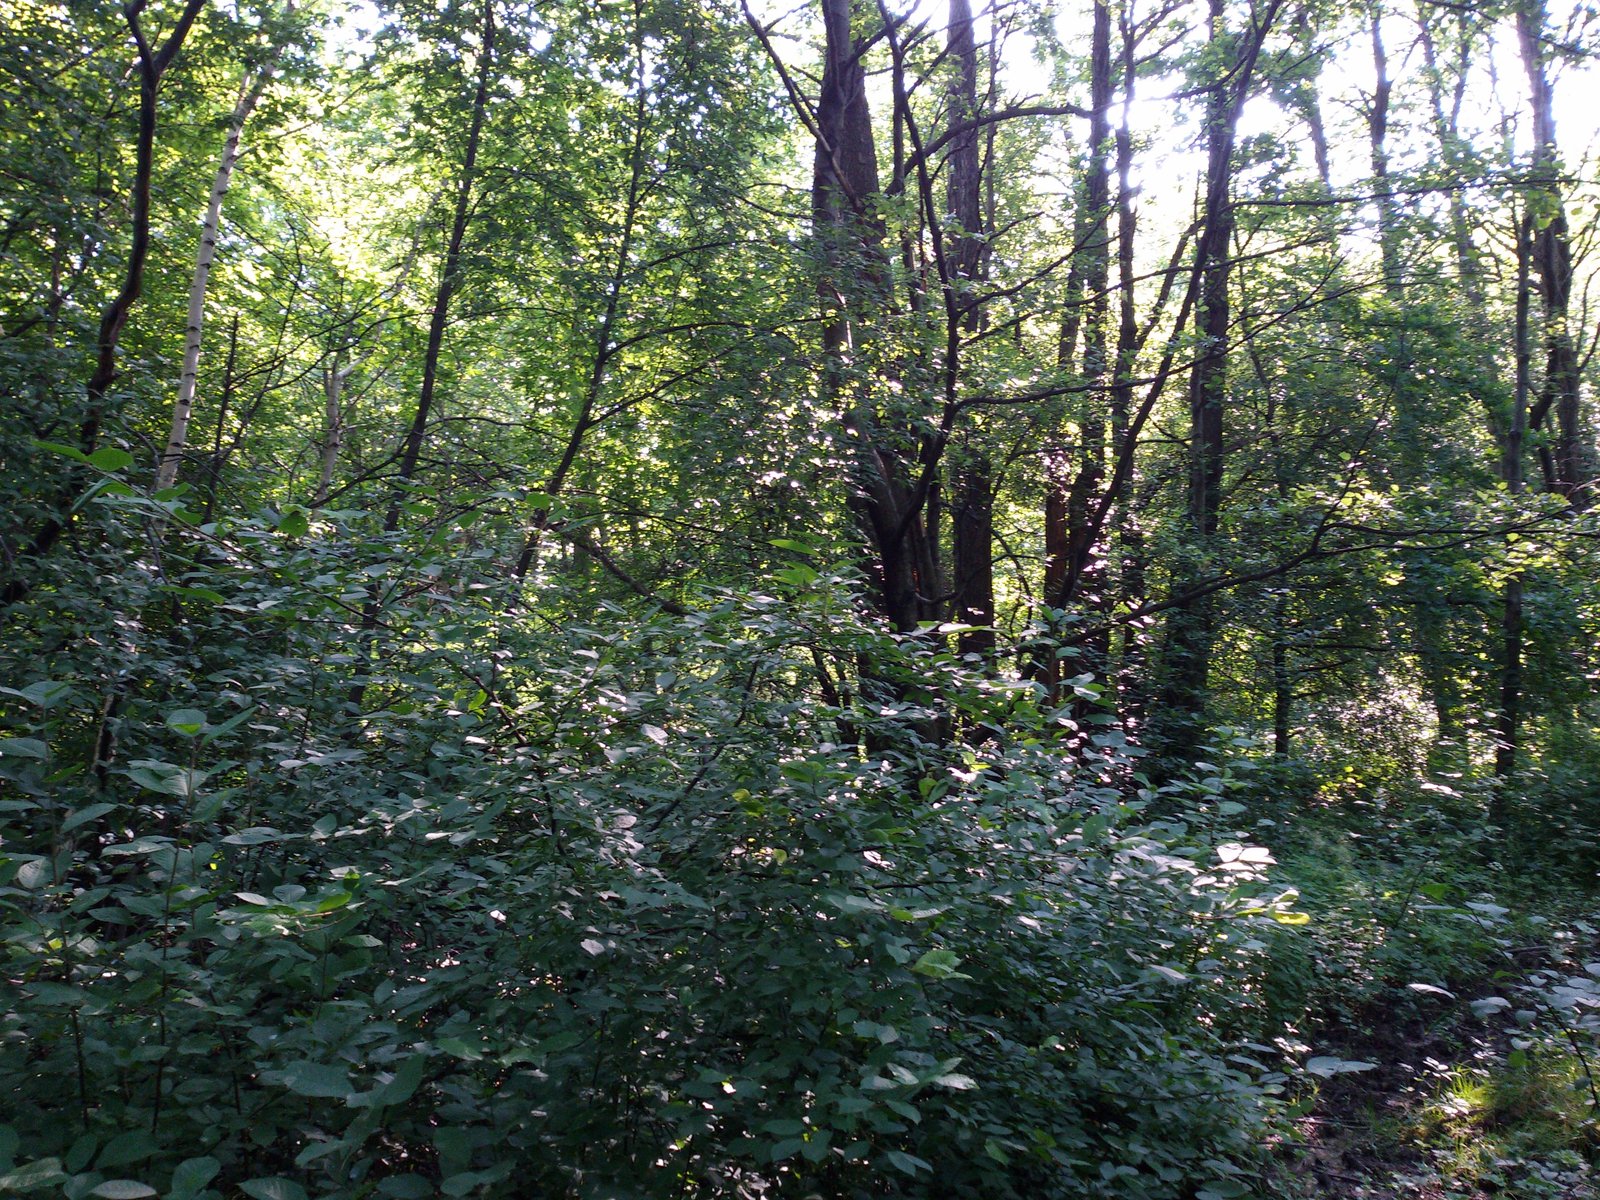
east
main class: Woodland
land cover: Broadleaved woodland
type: mesophytic deciduous forest
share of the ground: 50 - 75 %
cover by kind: broadleaved forest trees 70 %, shrubs 20 %, herbaceous plants 10 %
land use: Semi-natural and natural areas not in use
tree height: > 5 m
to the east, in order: Broadleaved woodland; Grassland with sparse tree/shrub cover; Shrubland with sparse tree cover; Rape and turnip rape; Broadleaved woodland; Arable land (only in case pi)
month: June
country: PL
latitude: 50.0264
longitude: 21.5954
